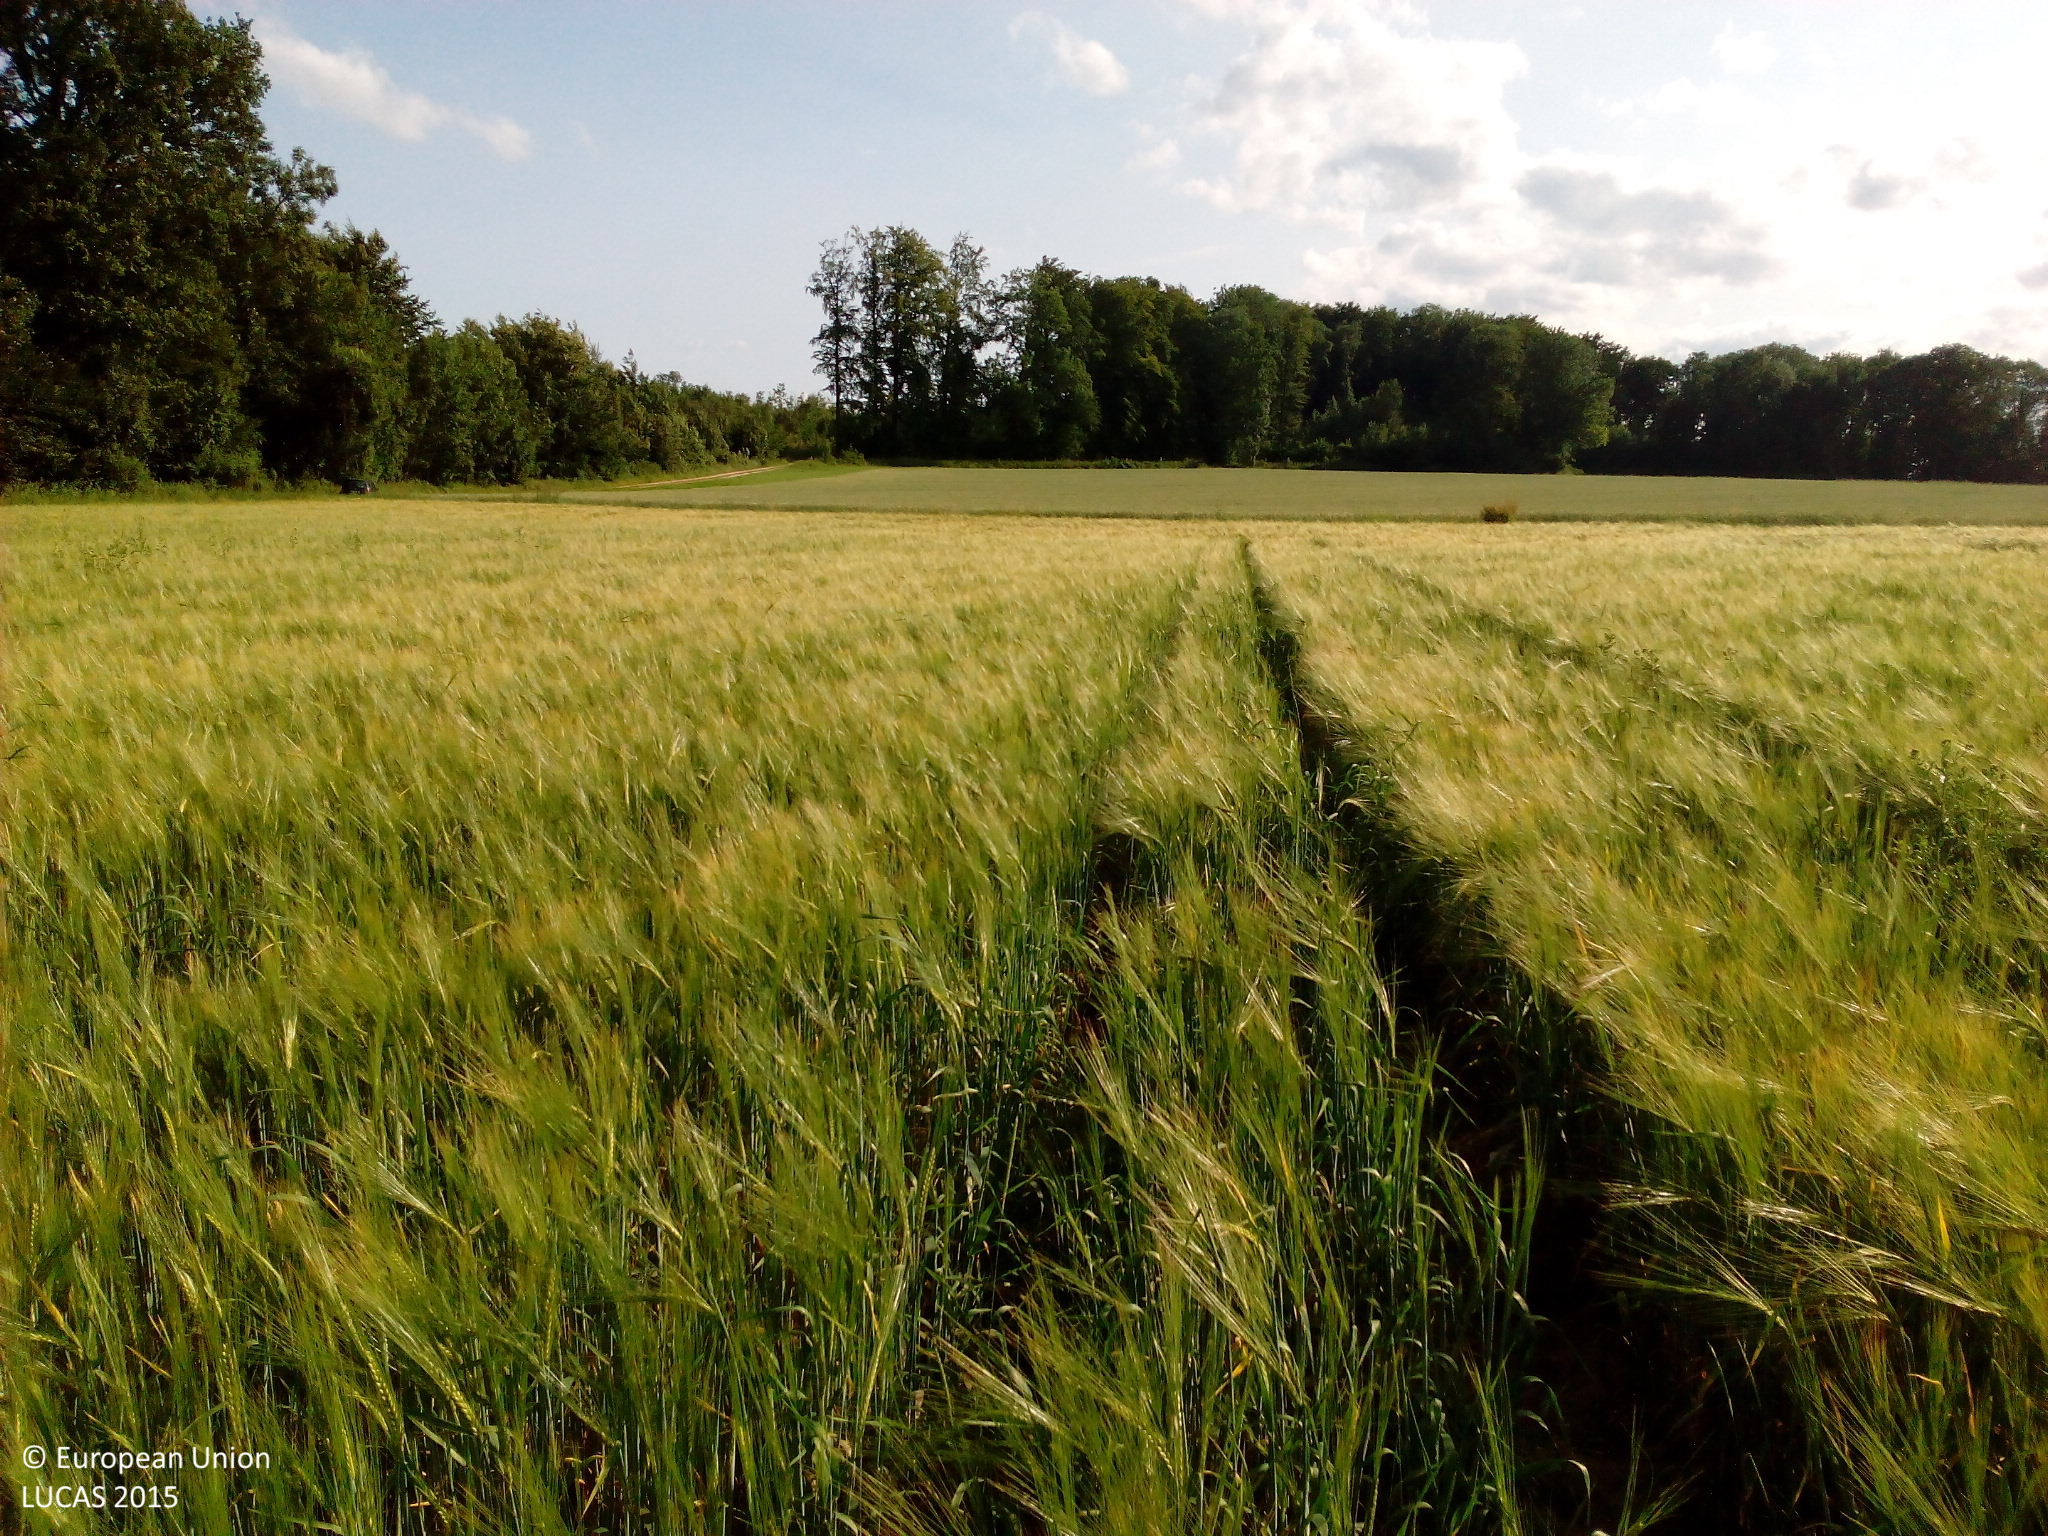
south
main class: Cropland
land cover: Barley
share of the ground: > 75 %
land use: Agriculture (excluding fallow land and kitchen gardens)
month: July
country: DE
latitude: 48.6373
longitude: 9.8508
